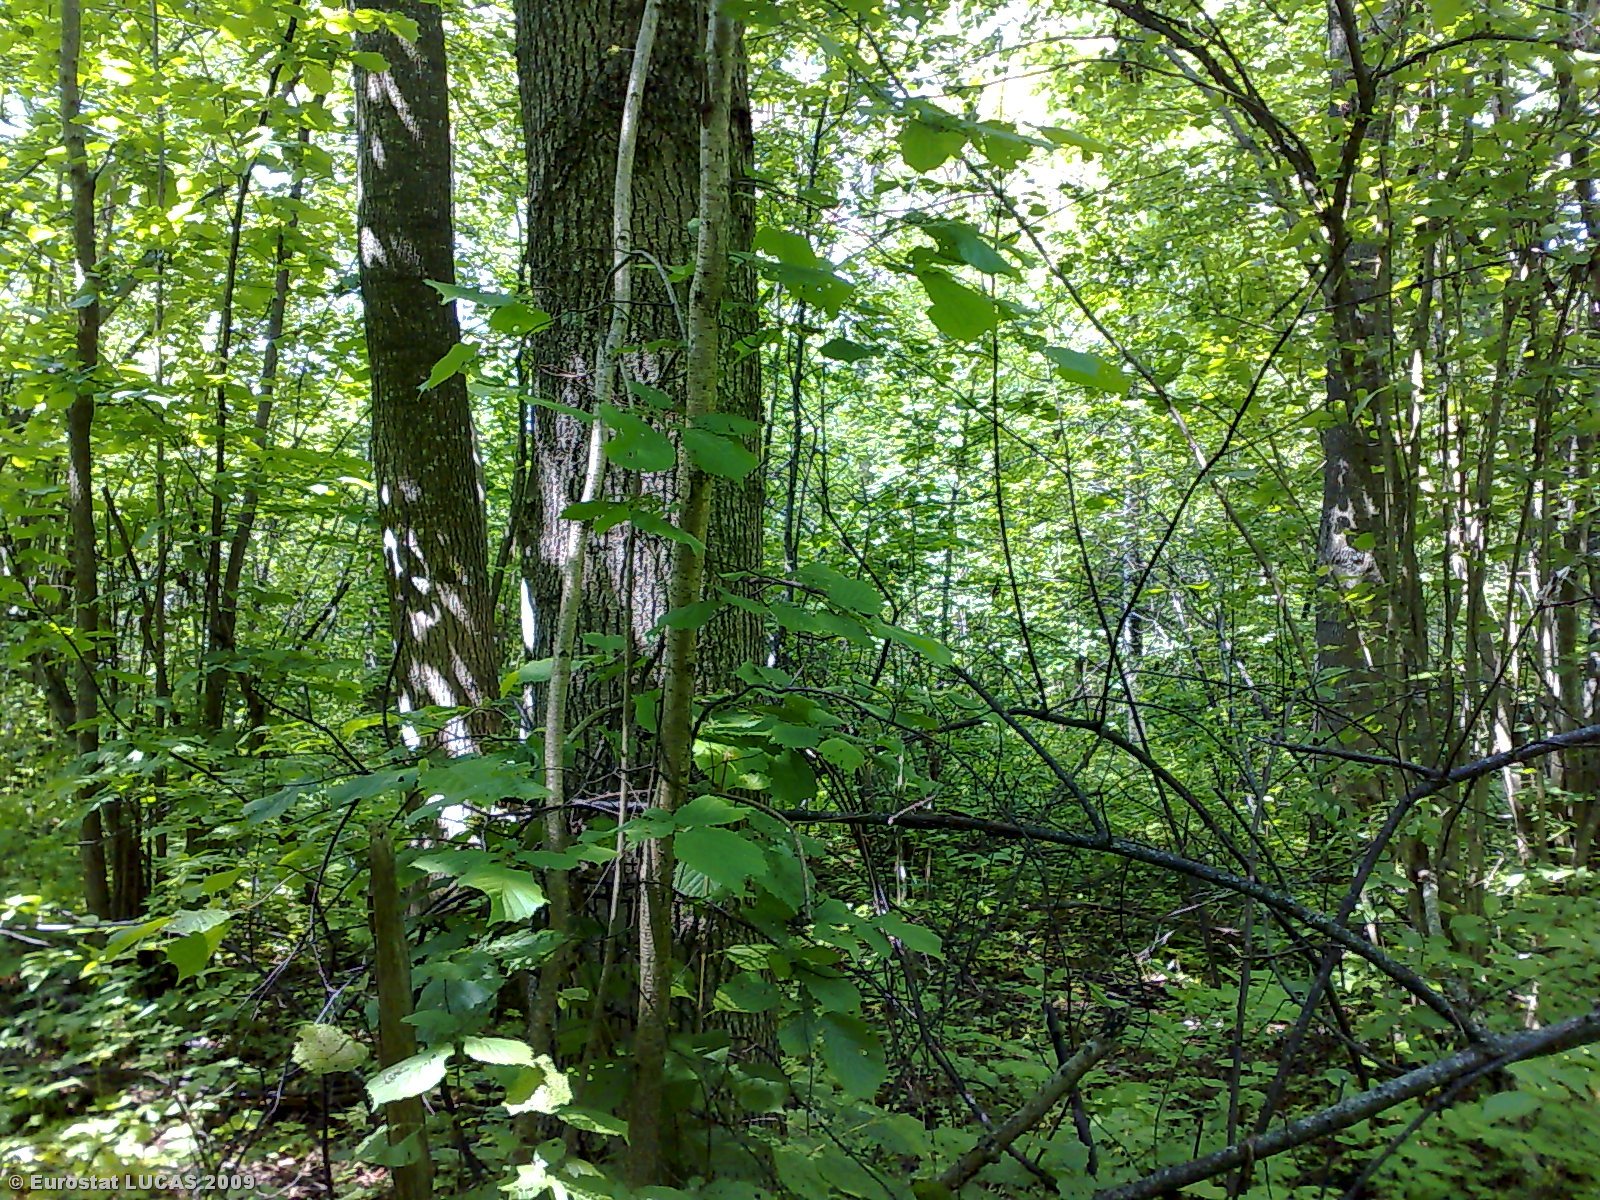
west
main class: Woodland
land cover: Broadleaved woodland
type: mesophytic deciduous forest
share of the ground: > 75 %
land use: Forestry
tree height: > 5 m
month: June
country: LT
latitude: 56.1840
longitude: 24.1551
